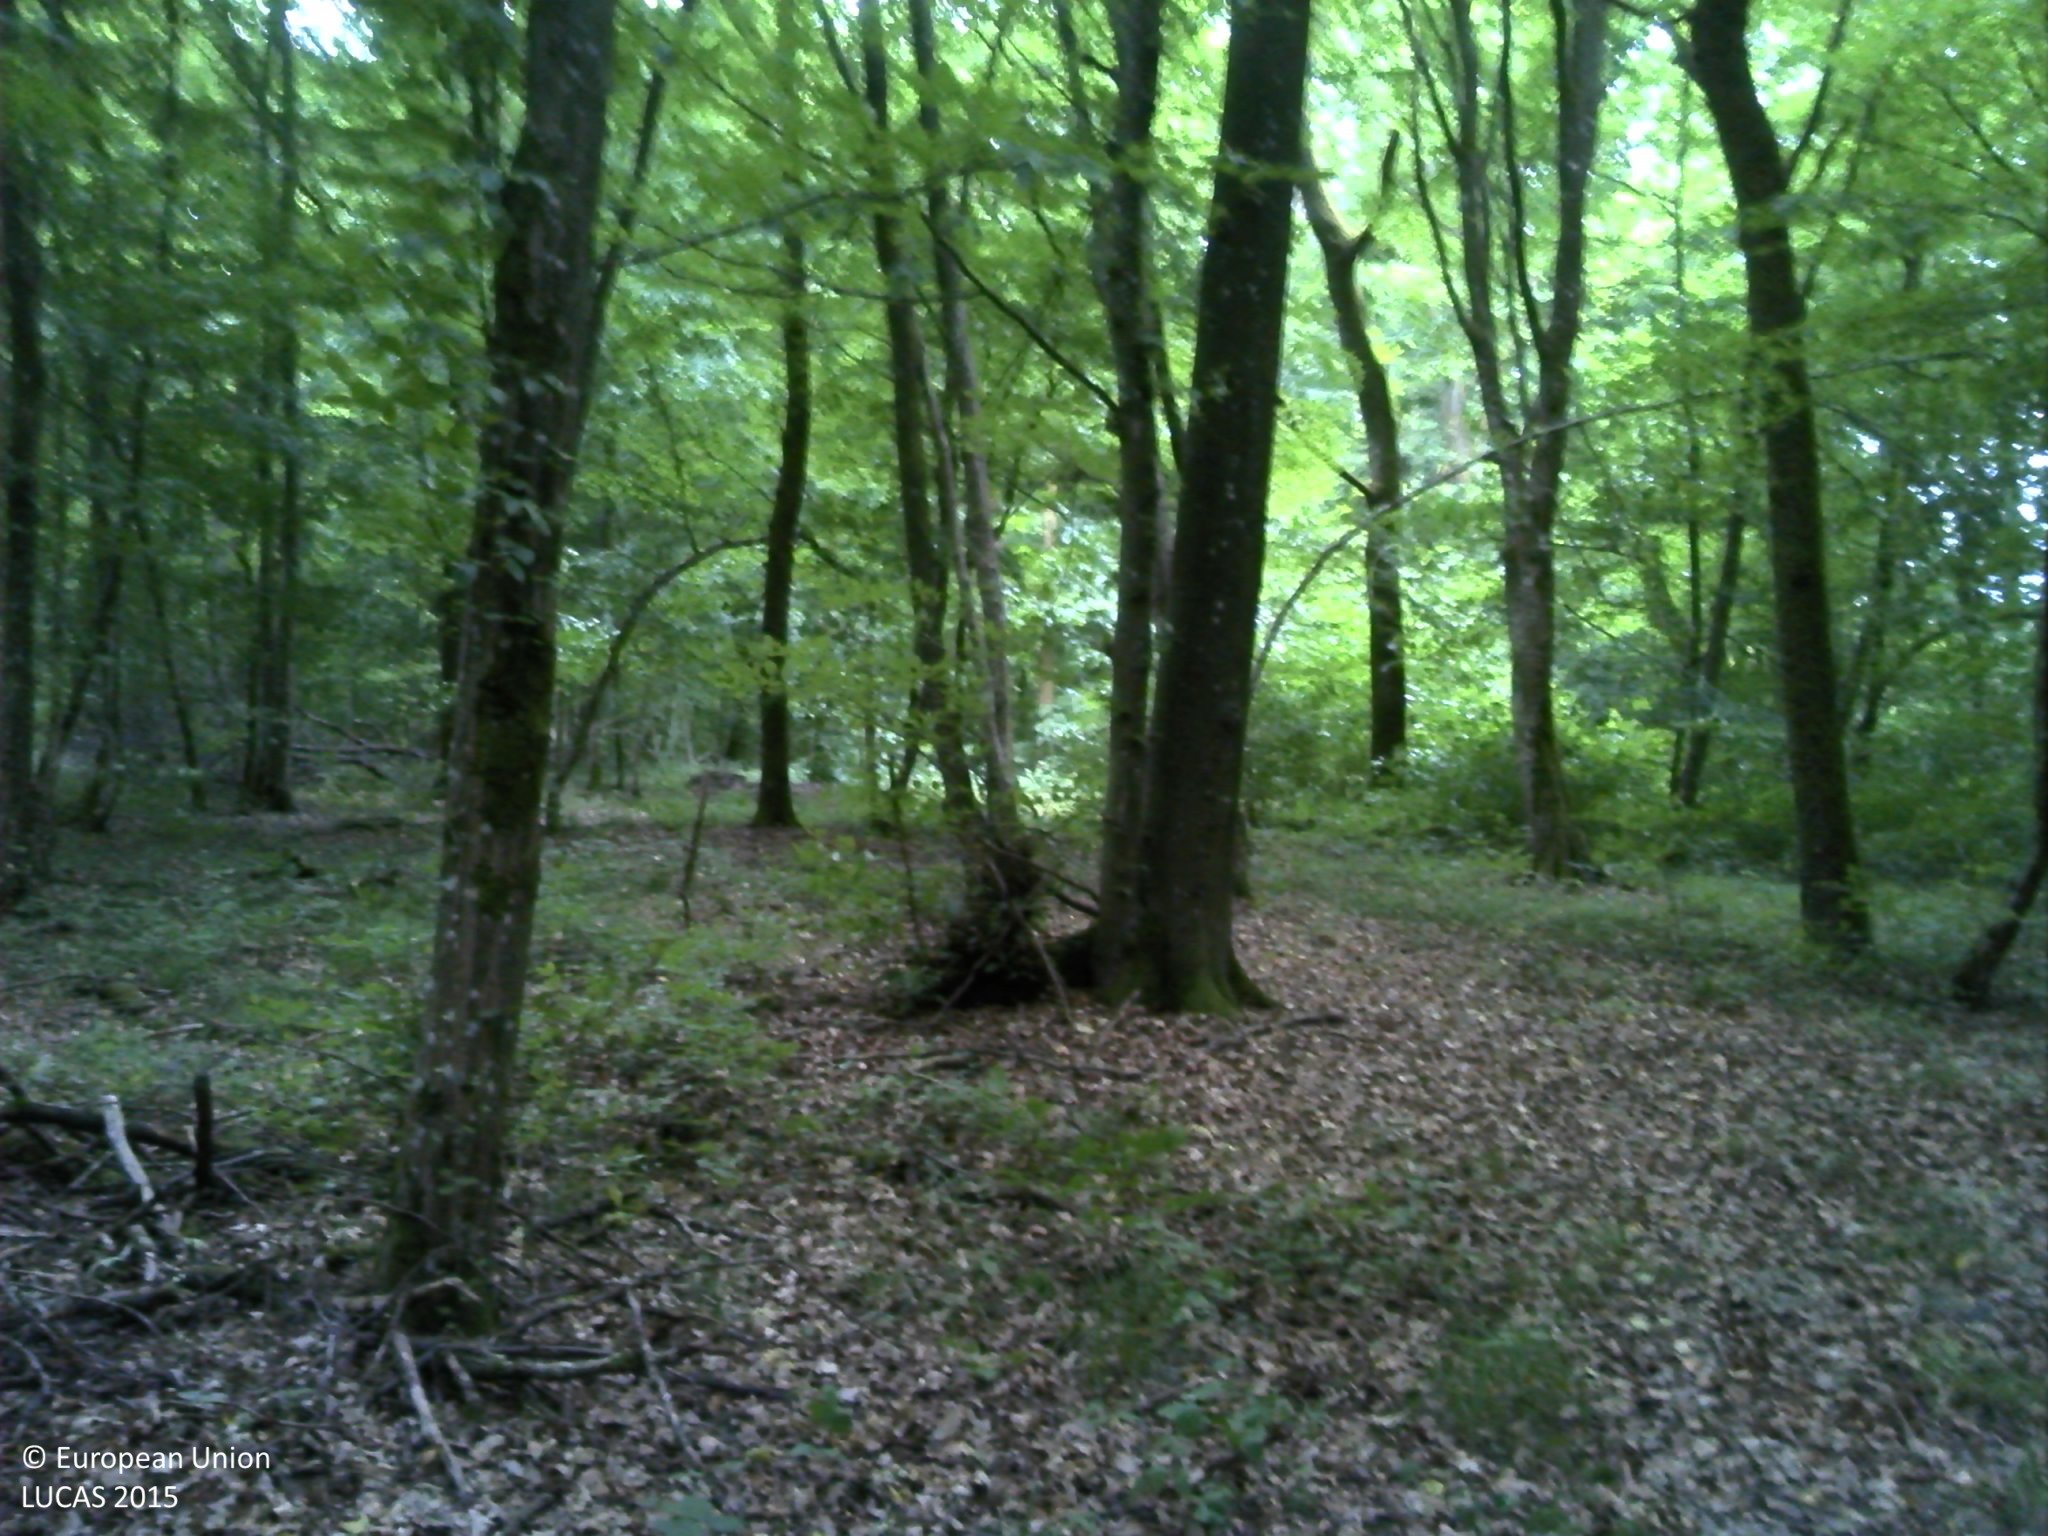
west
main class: Woodland
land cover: Broadleaved woodland
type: mesophytic deciduous forest
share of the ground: > 75 %
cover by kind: broadleaved forest trees 100 %
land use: Forestry
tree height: > 5 m
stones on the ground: < 10 %
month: July
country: FR
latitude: 49.3194
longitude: 6.4643
